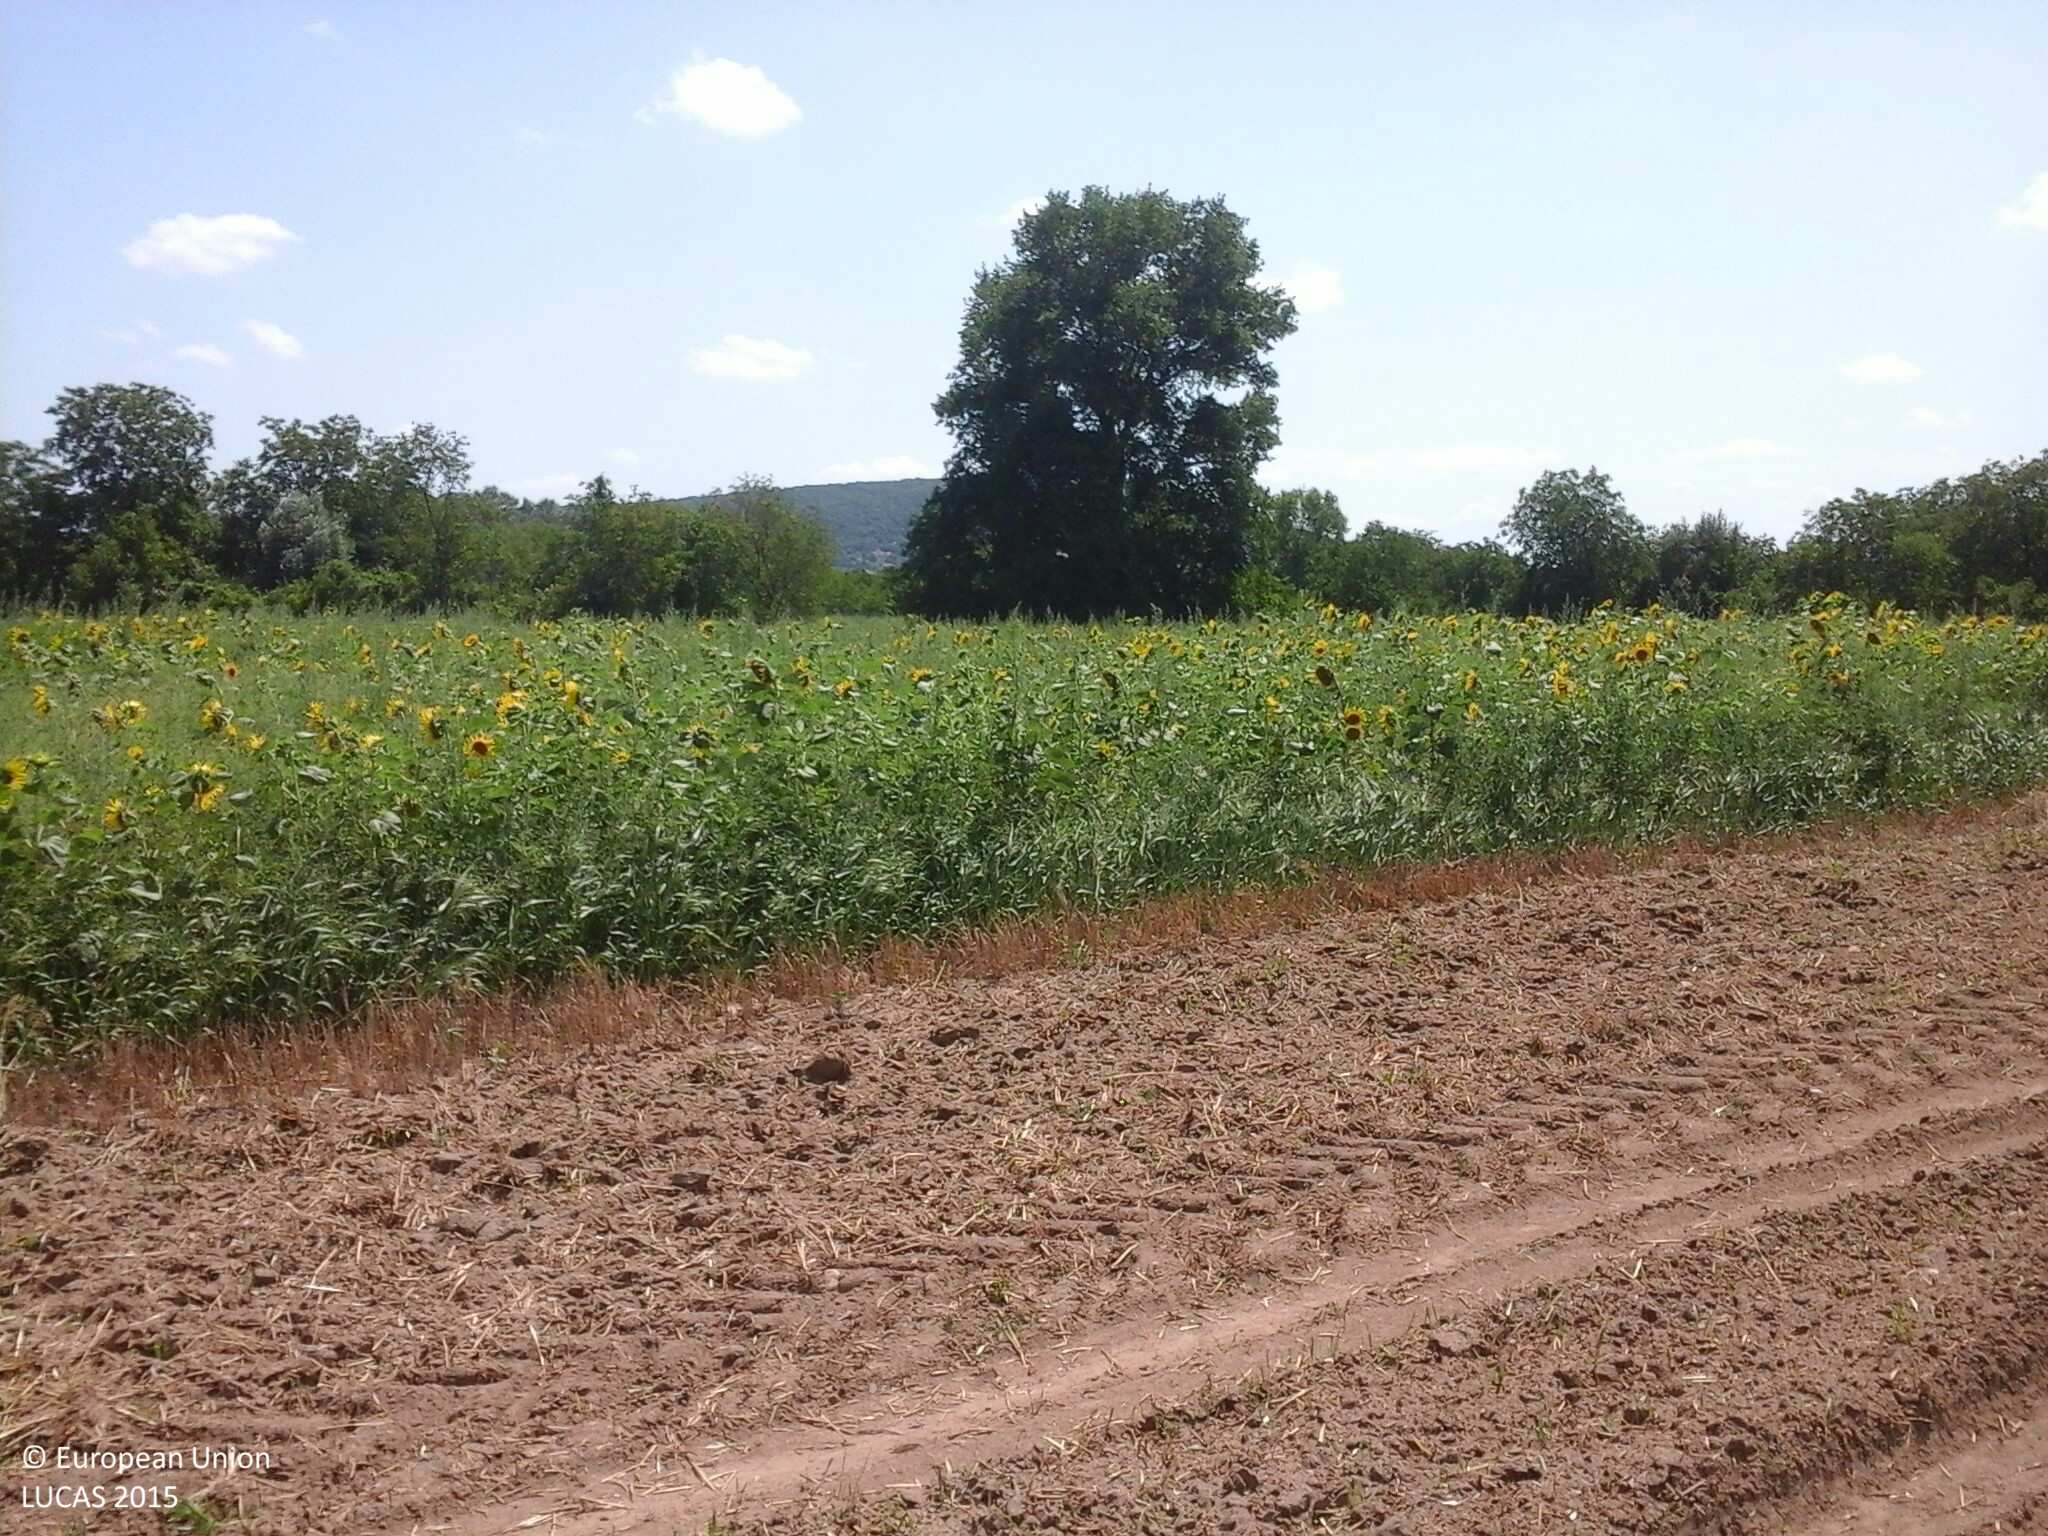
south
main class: Cropland
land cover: Common wheat
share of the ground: < 10 %
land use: Agriculture (excluding fallow land and kitchen gardens)
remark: Harvested field
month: July
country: HU
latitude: 47.0249
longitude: 17.2815
